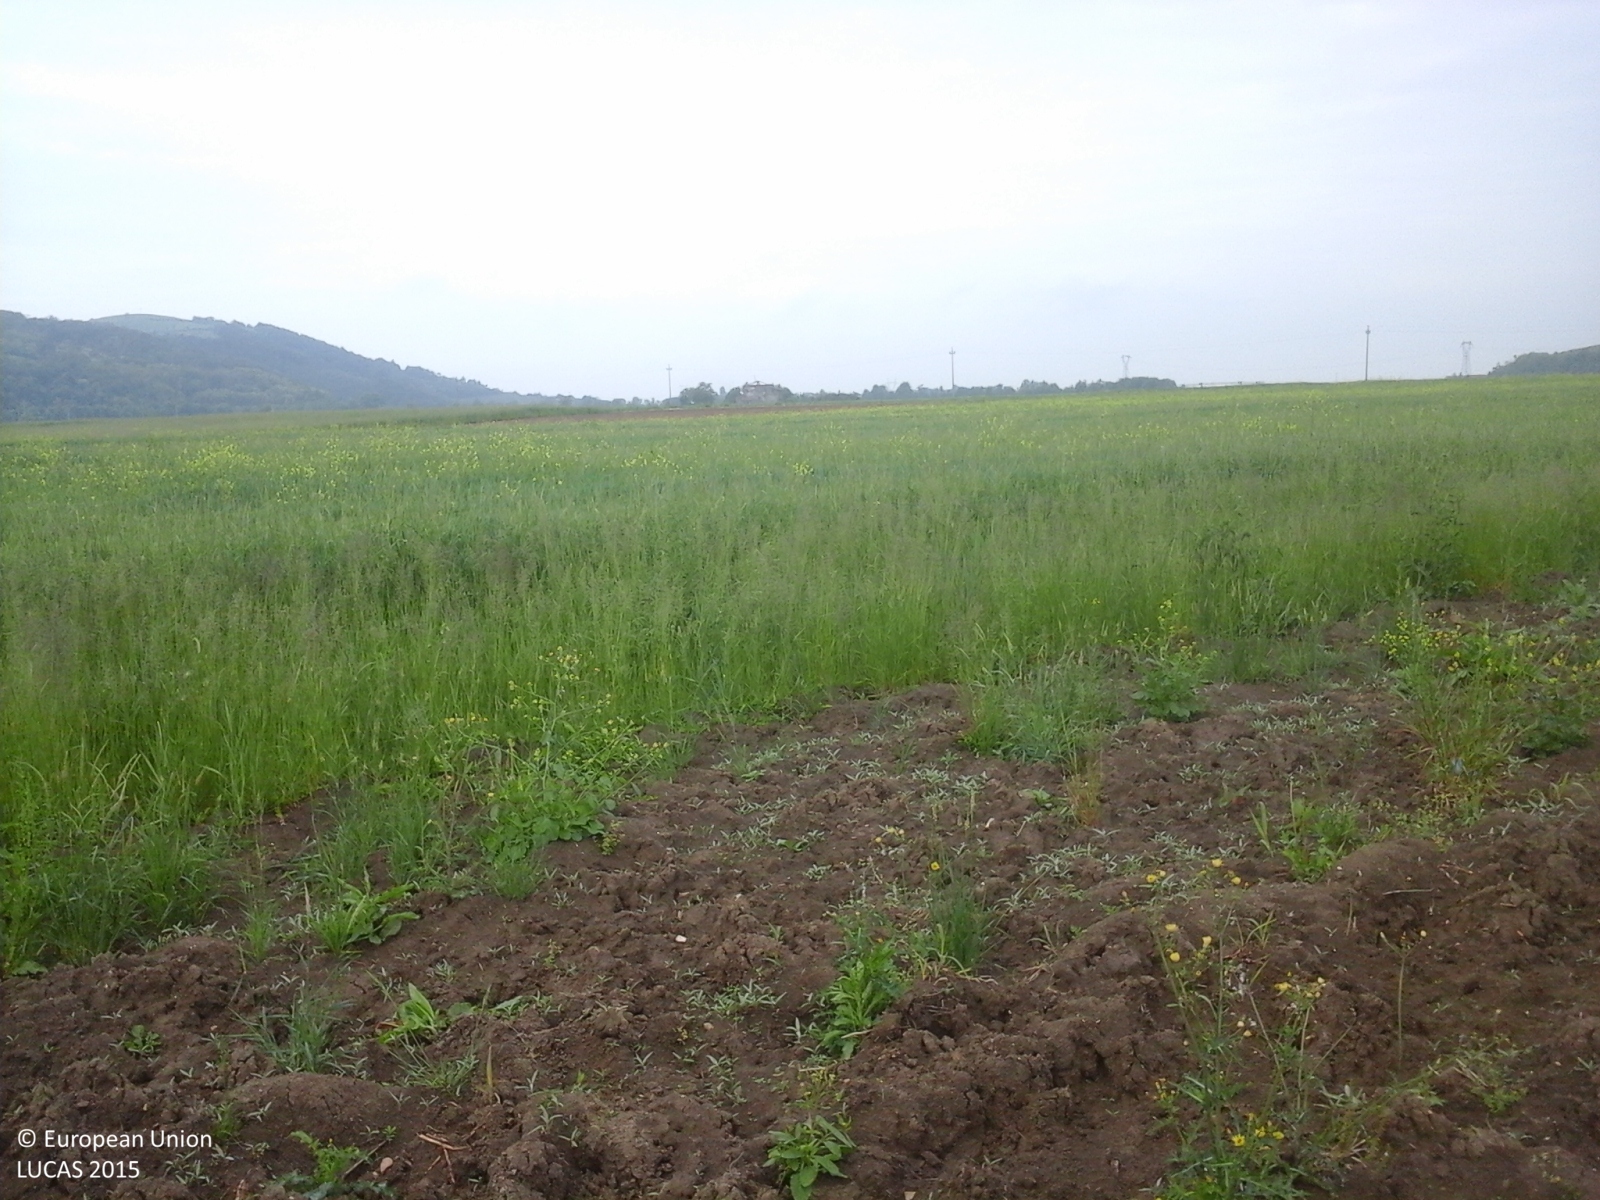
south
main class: Grassland
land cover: Spontaneously vegetated surfaces
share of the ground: 25 - 50 %
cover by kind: consolidated bare surface 80 %, herbaceous plants 20 %
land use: Fallow land
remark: Tilled/Sowed
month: May
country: IT
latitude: 45.3658
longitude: 11.6187
